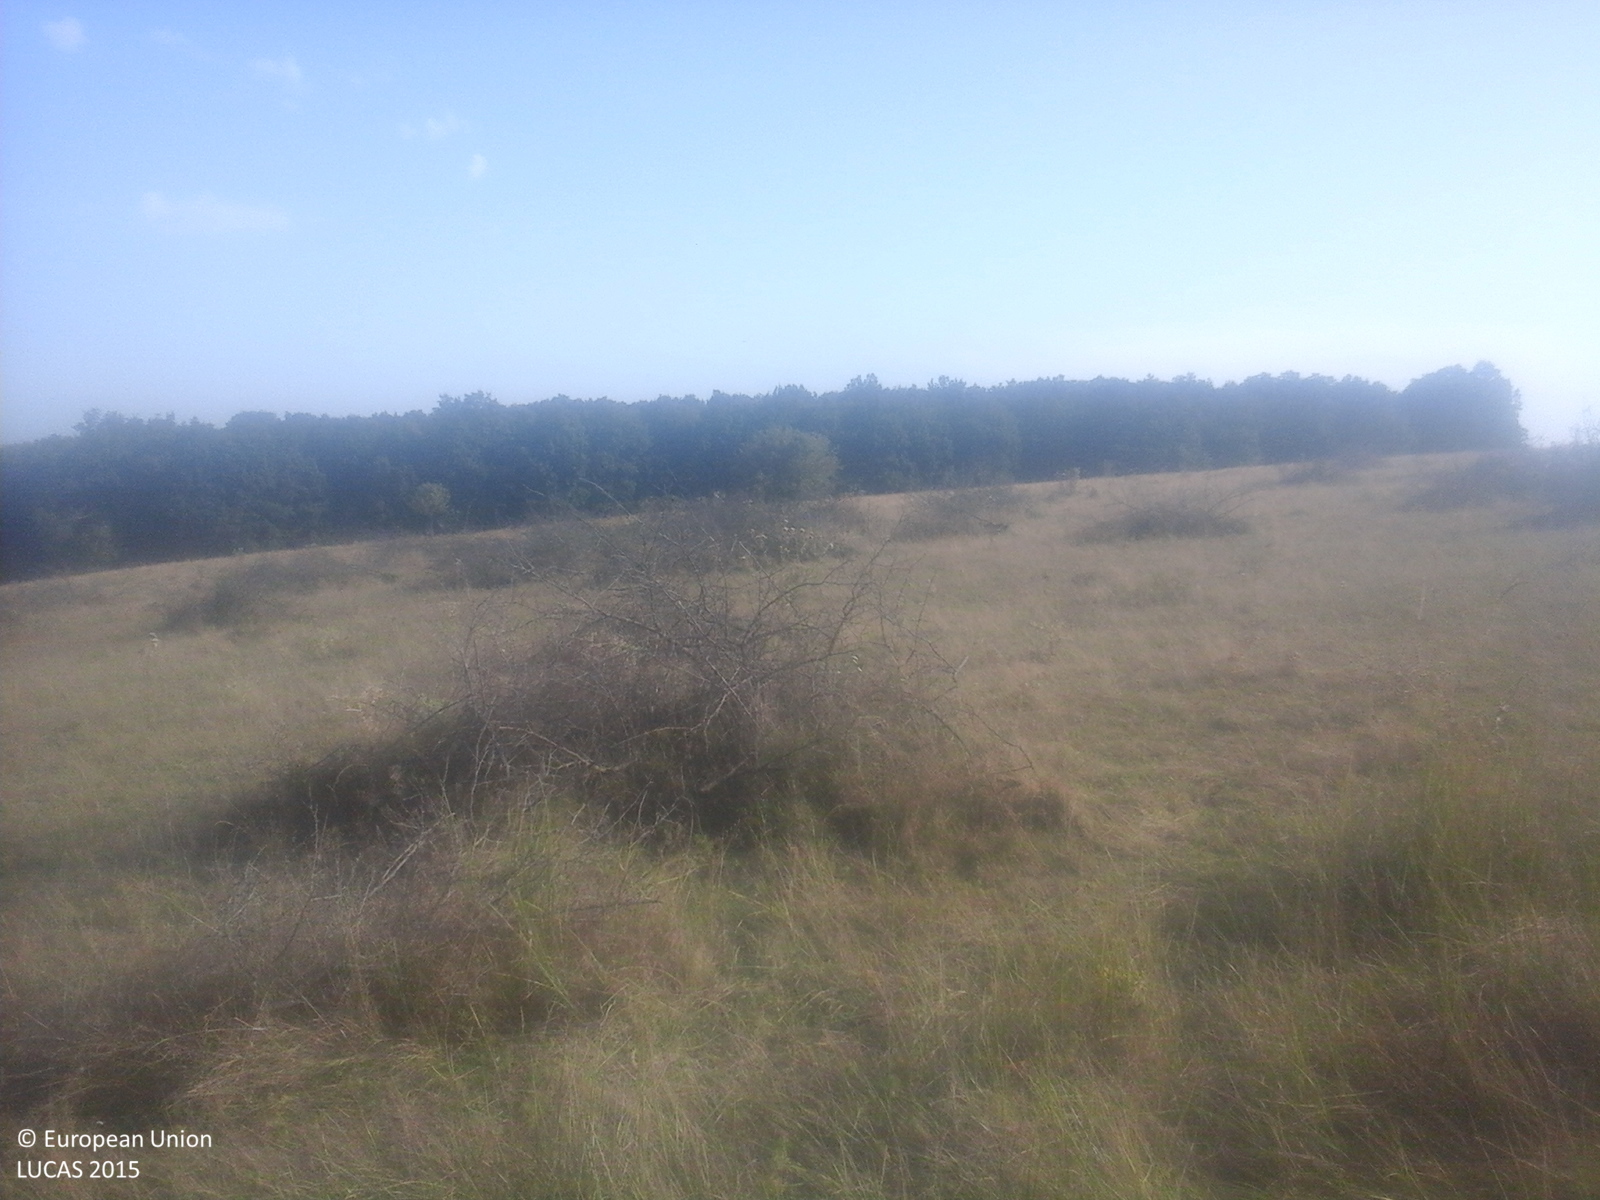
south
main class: Grassland
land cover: Grassland with sparse tree/shrub cover
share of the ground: > 75 %
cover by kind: herbaceous plants 85 %, shrubs 10 %, broadleaved forest trees 5 %
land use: Agriculture (excluding fallow land and kitchen gardens)
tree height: < 5 m
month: September
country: RO
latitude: 46.9724
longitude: 23.7587
